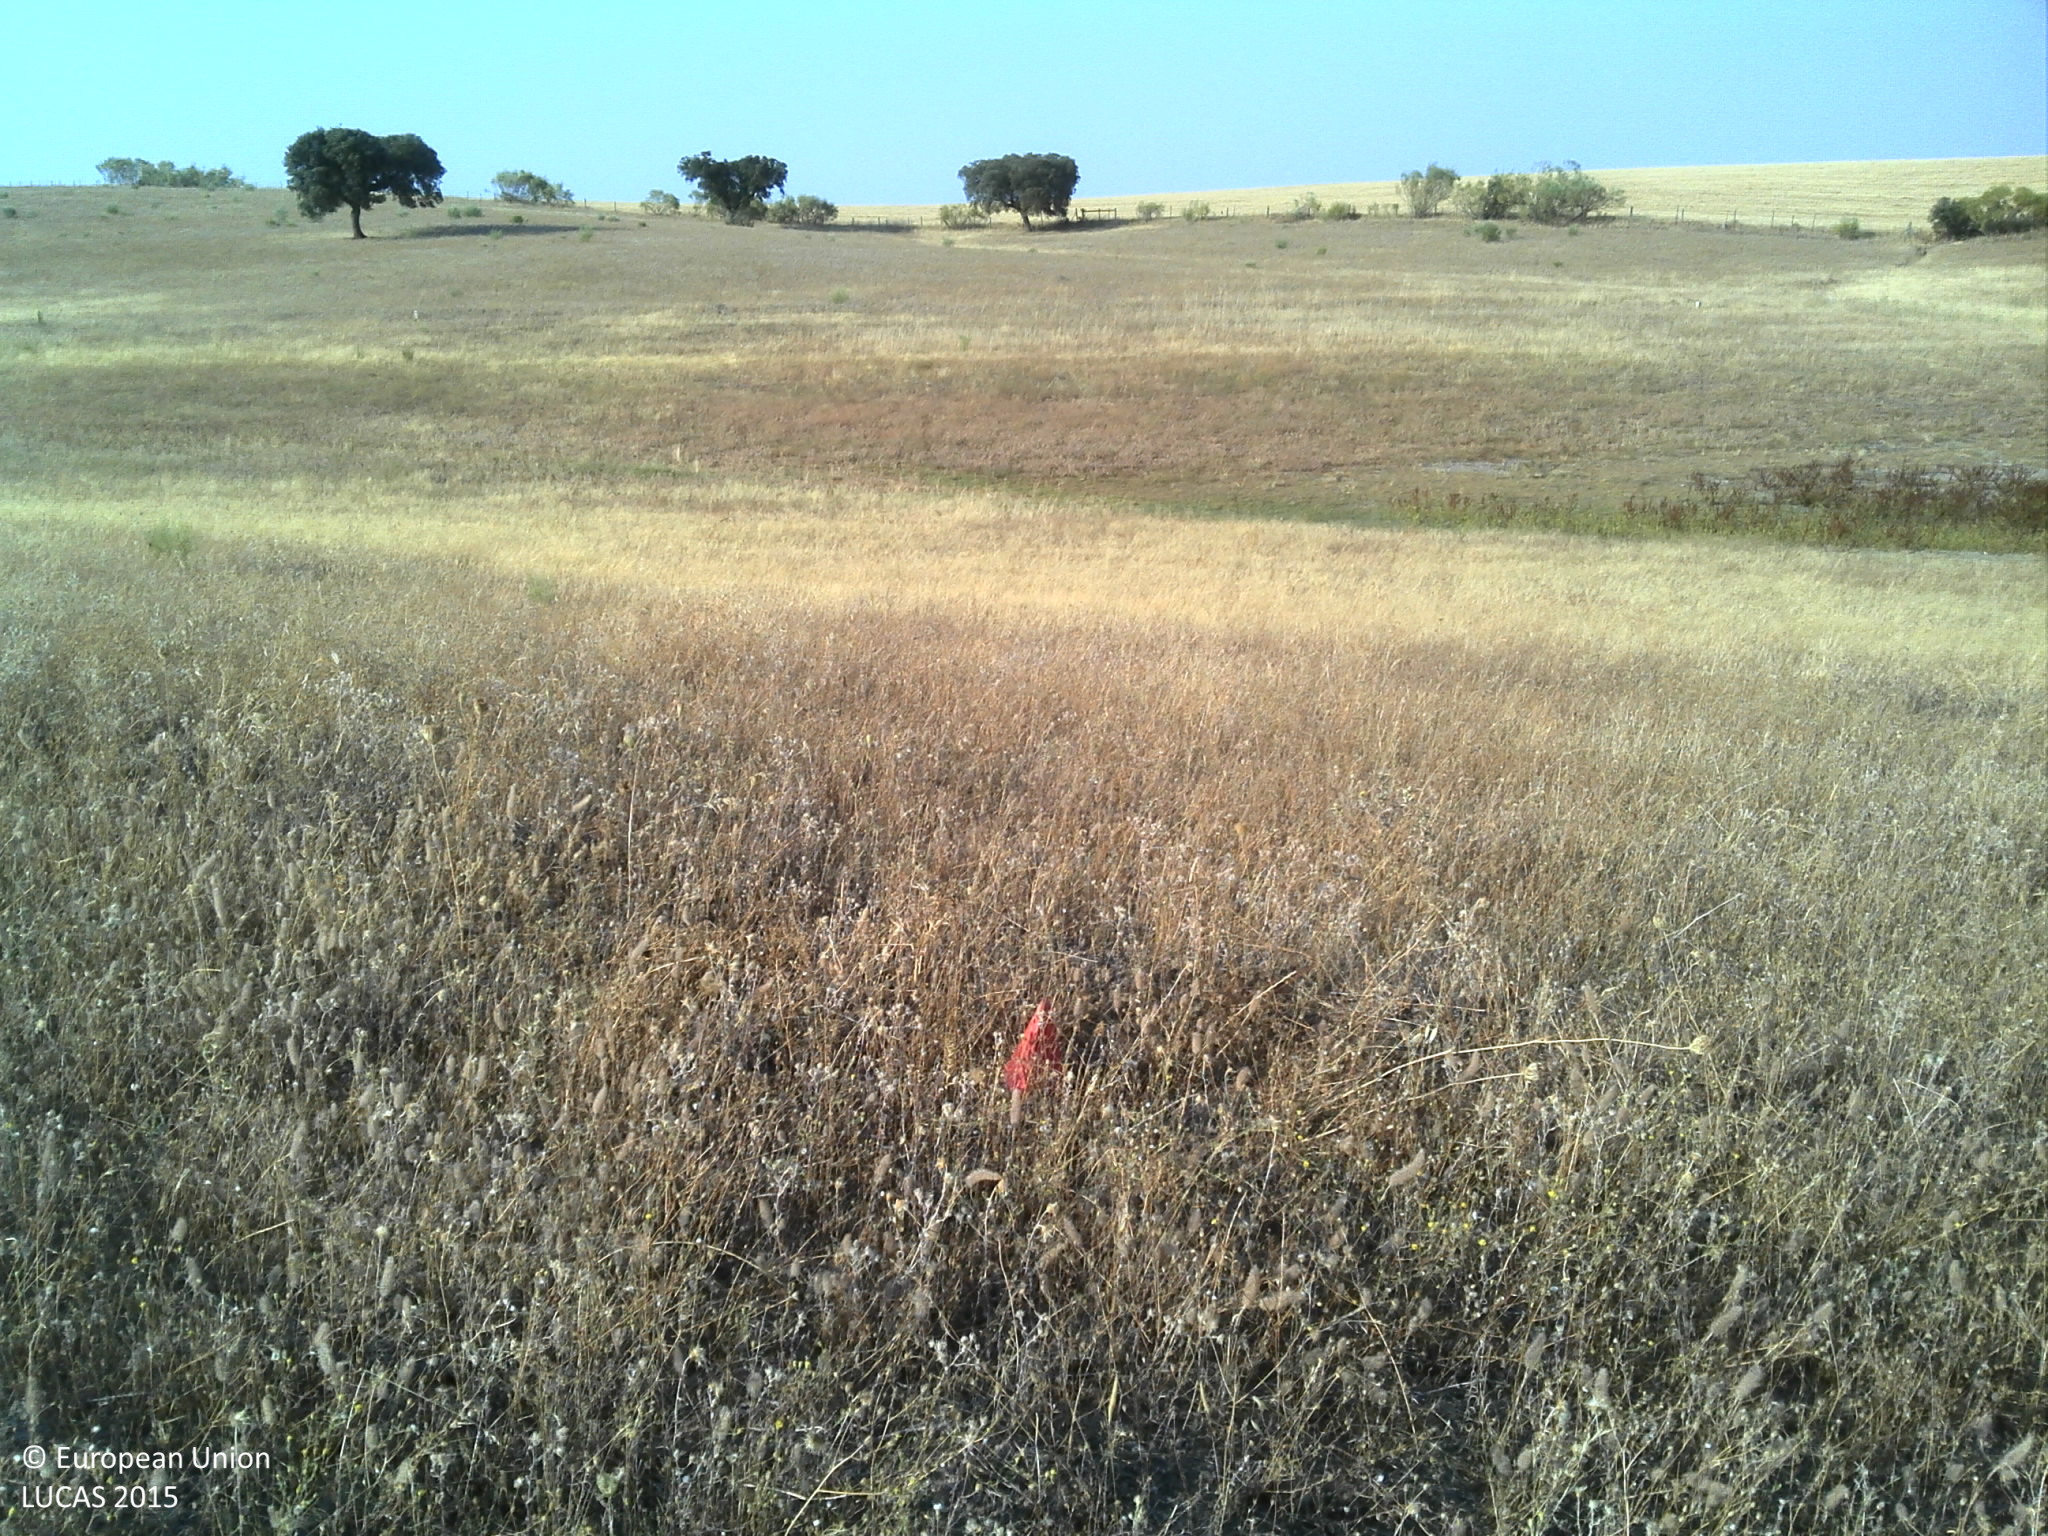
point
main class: Grassland
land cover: Grassland without tree/shrub cover
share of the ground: > 75 %
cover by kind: herbaceous plants 100 %
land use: Agriculture (excluding fallow land and kitchen gardens)
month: June
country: PT
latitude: 38.3244
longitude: -7.3281
